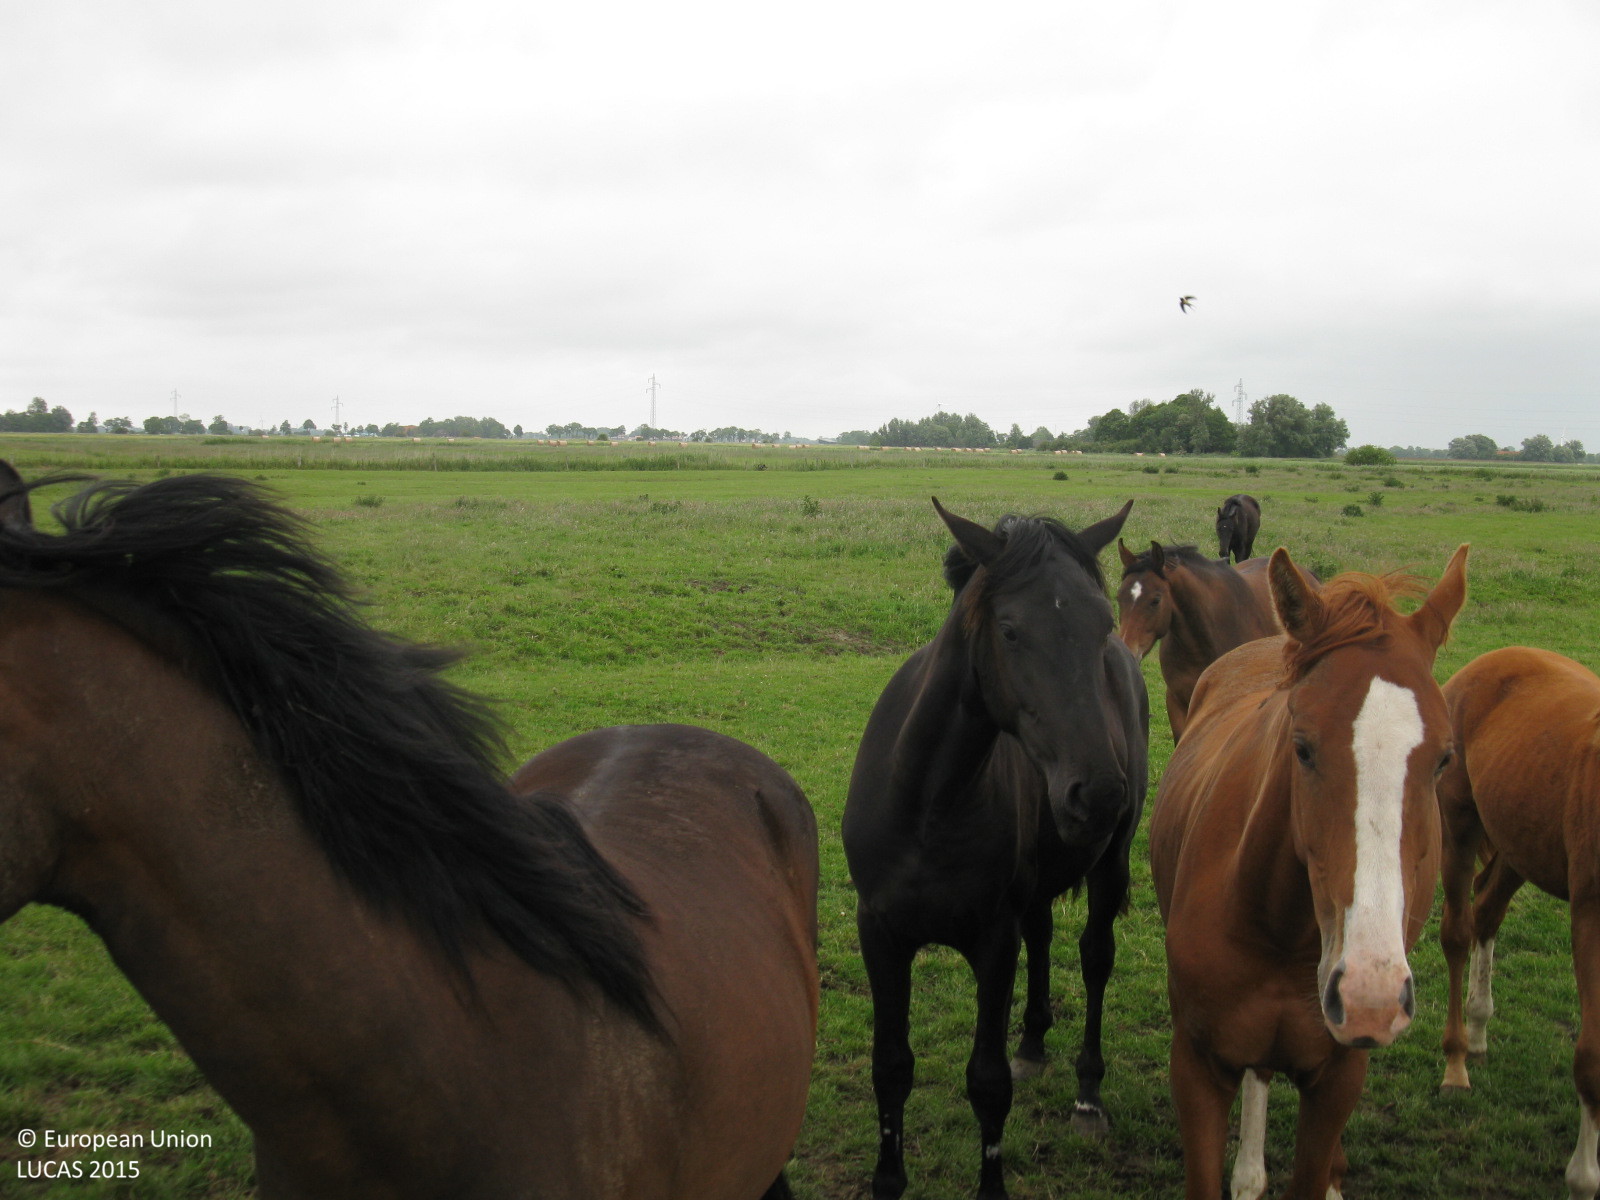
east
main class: Grassland
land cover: Grassland without tree/shrub cover
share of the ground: > 75 %
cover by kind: herbaceous plants 100 %
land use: Agriculture (excluding fallow land and kitchen gardens)
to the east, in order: Grassland without tree/shrub cover; Fences; Grass margins; Ditches and canals; Grass margins; Fences; Grassland without tree/shrub cover; Fences; Grass margins; Tracks; Grass margins; Fences; Grassland without tree/shrub cover
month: June
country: DE
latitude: 53.6534
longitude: 7.8977
